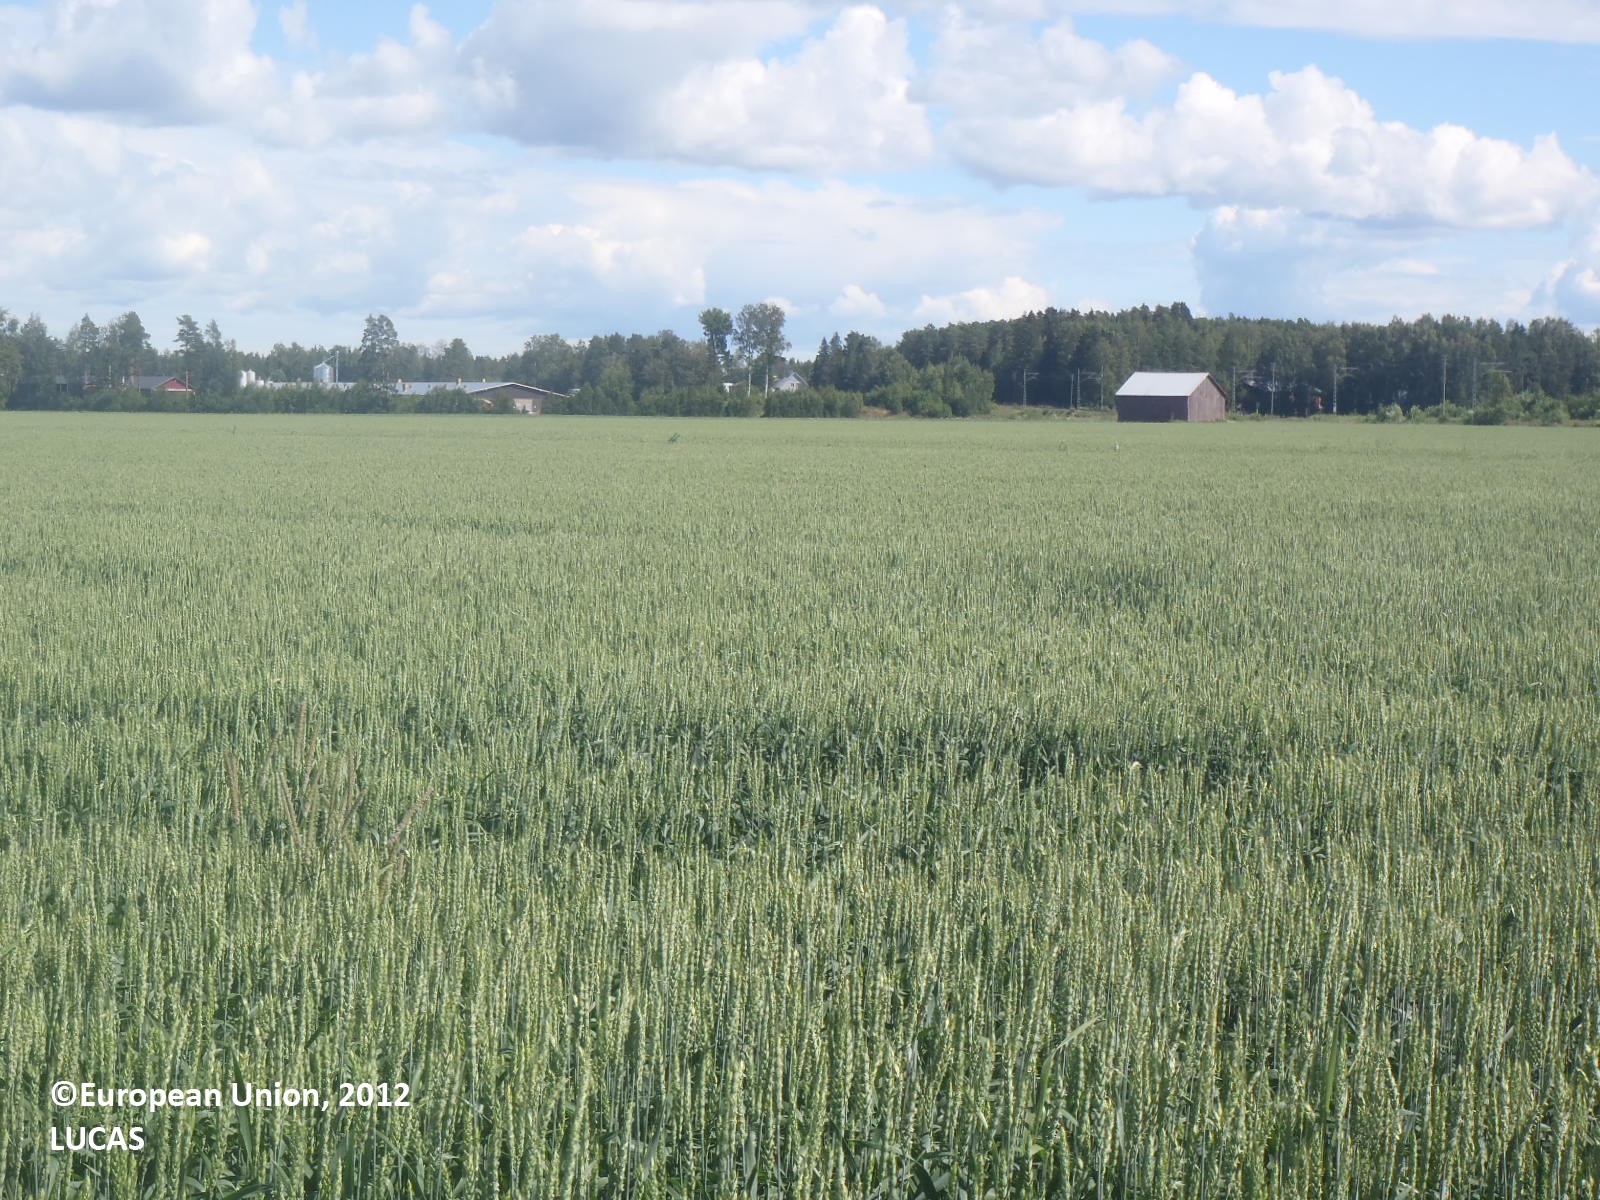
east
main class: Cropland
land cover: Common wheat
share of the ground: > 75 %
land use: Agriculture (excluding fallow land and kitchen gardens)
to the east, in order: Common wheat
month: July
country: FI
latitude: 61.2032
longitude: 21.9496
